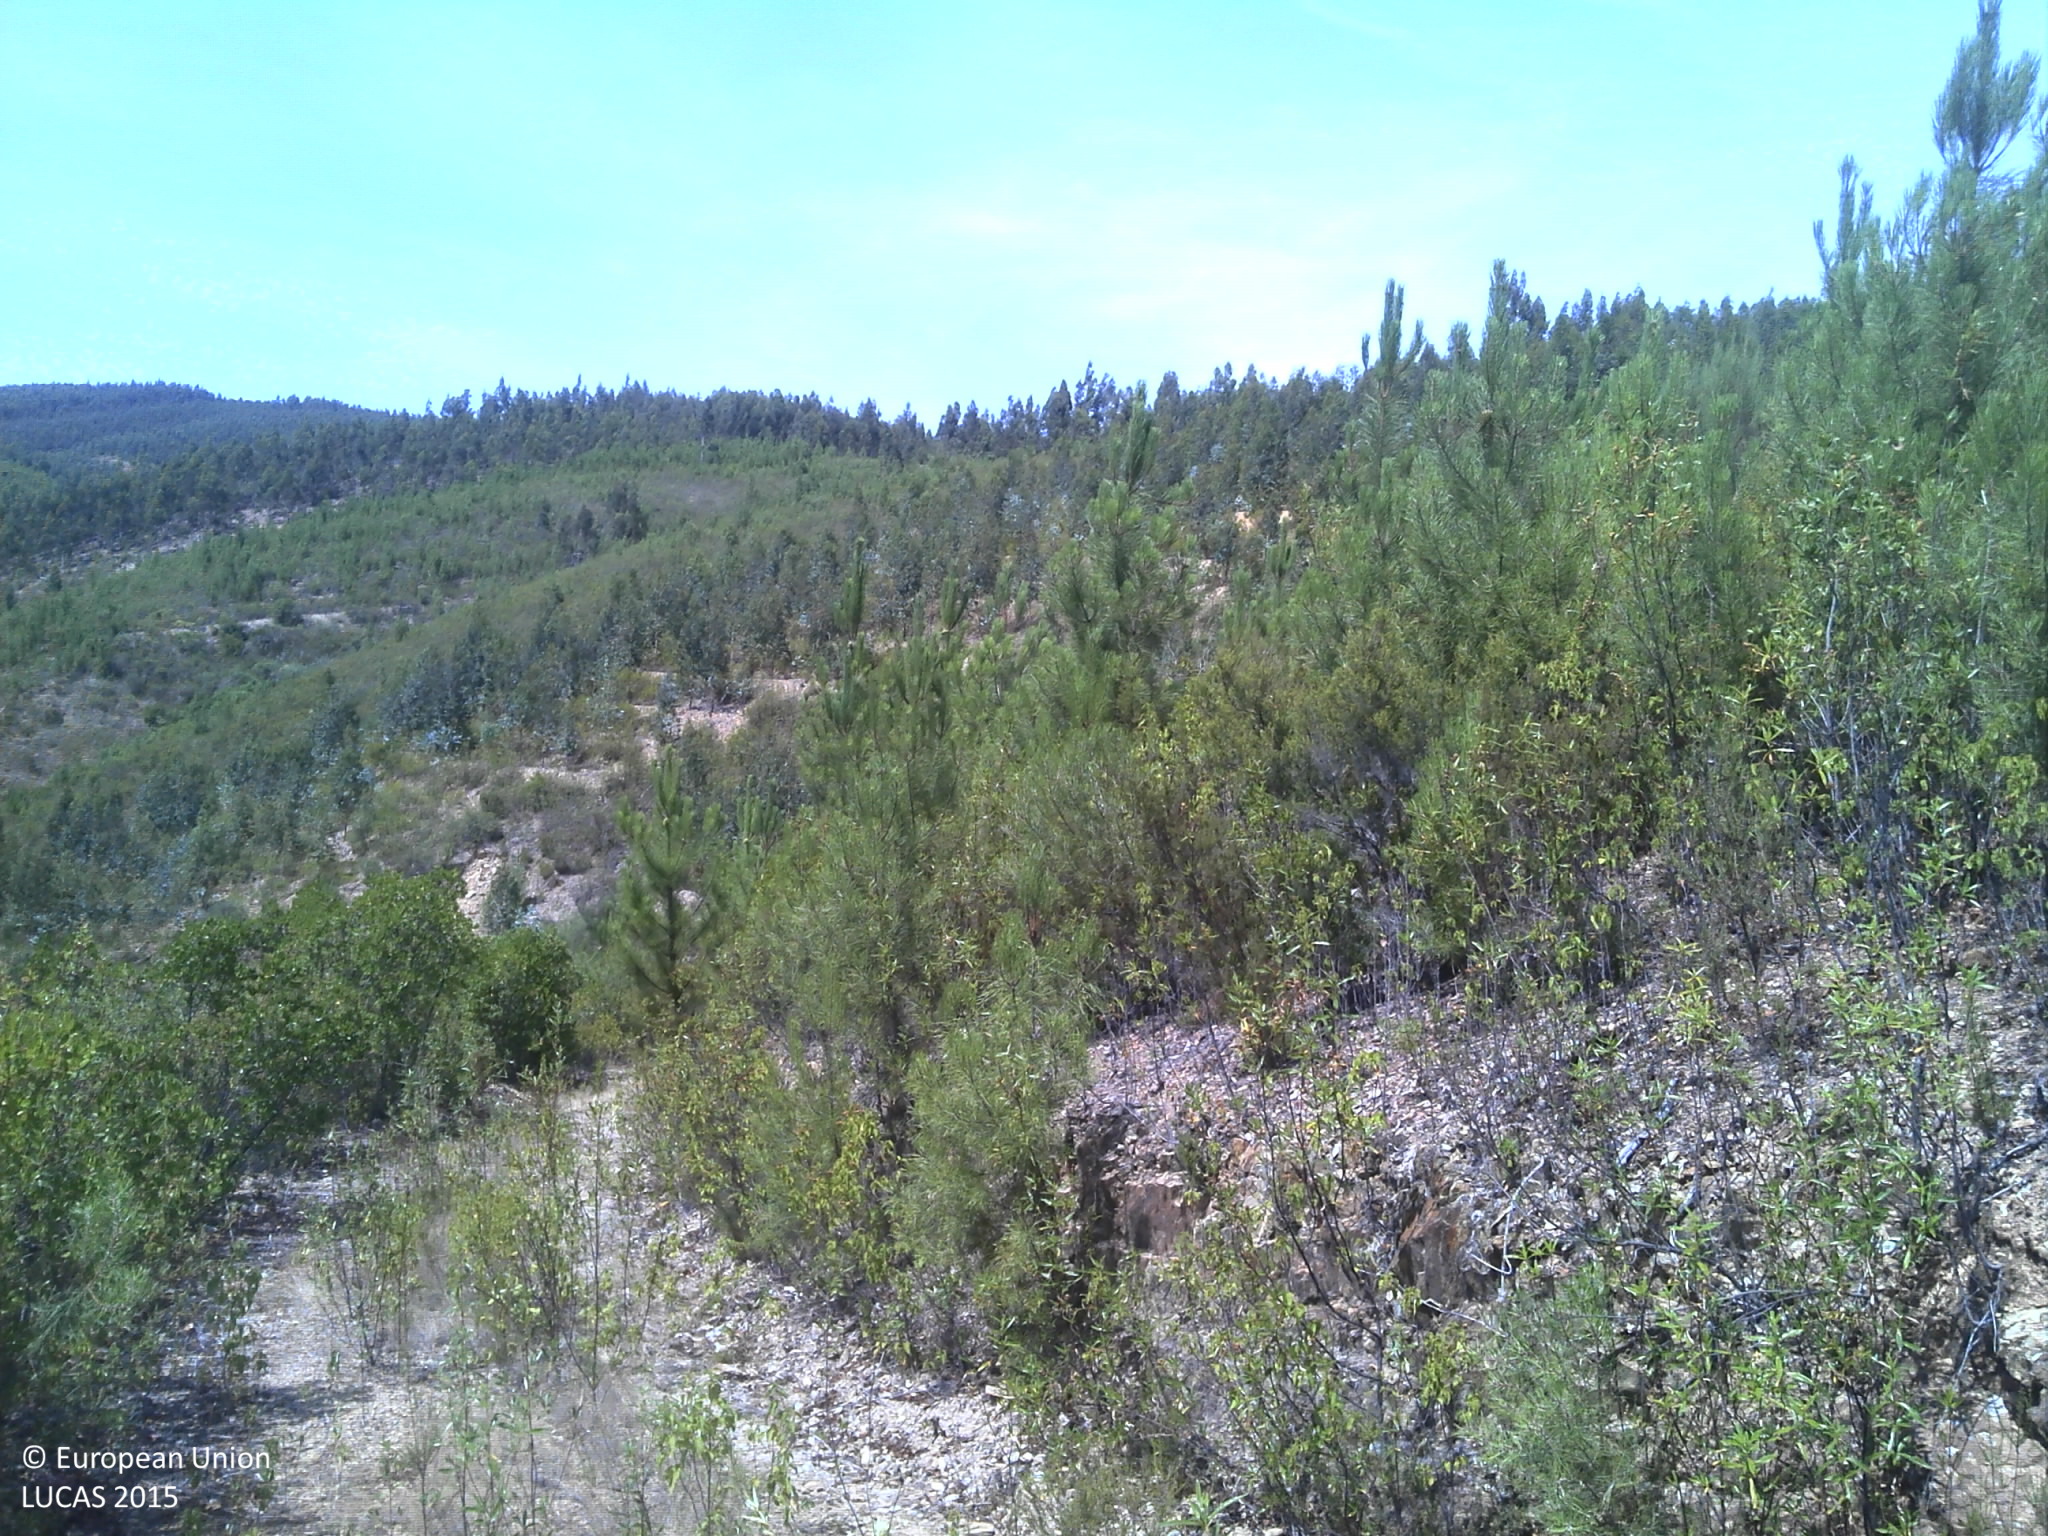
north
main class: Shrubland
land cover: Shrubland with sparse tree cover
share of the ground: 50 - 75 %
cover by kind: shrubs 75 %, unconsolidated bare surface 20 %, coniferous forest trees 5 %
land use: Semi-natural and natural areas not in use
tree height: < 5 m
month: July
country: PT
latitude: 40.0347
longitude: -7.8668
